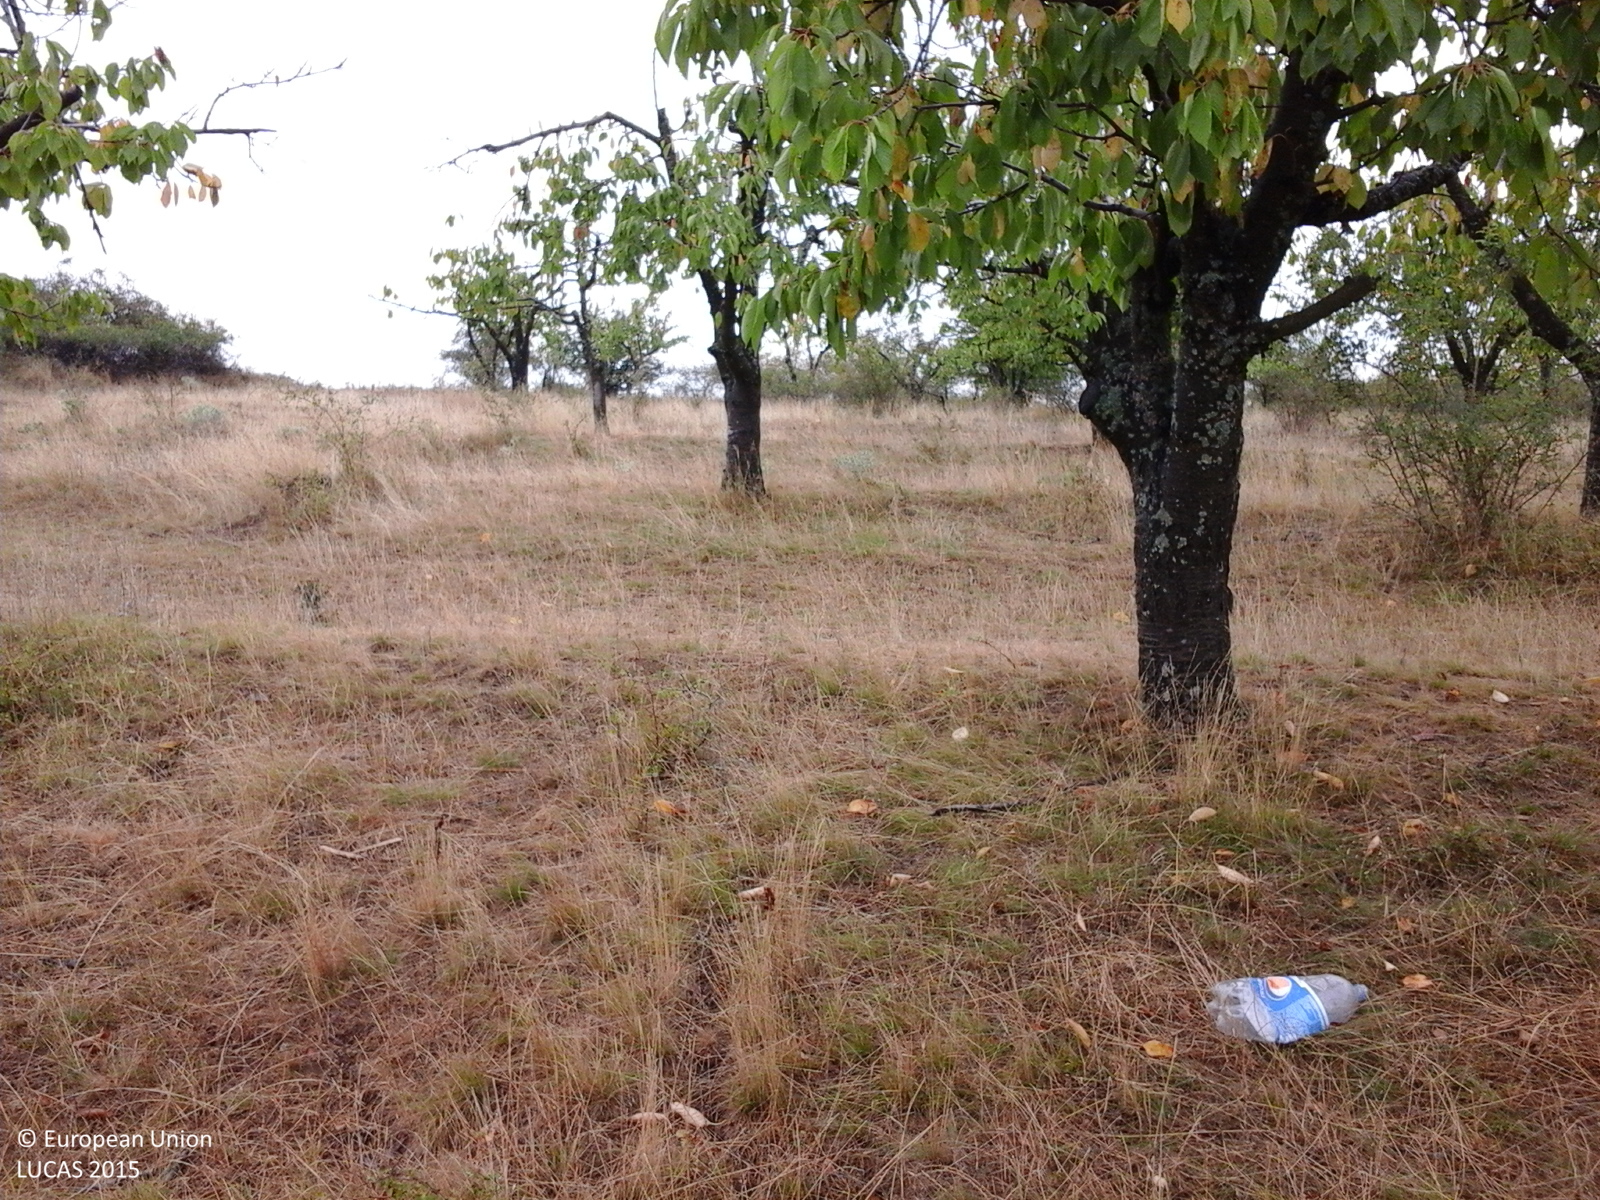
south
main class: Cropland
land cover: Cherry fruit
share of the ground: 50 - 75 %
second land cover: Grassland without tree/shrub cover
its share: > 75 %
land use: Agriculture (excluding fallow land and kitchen gardens)
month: August
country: RO
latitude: 45.9016
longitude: 21.4151
